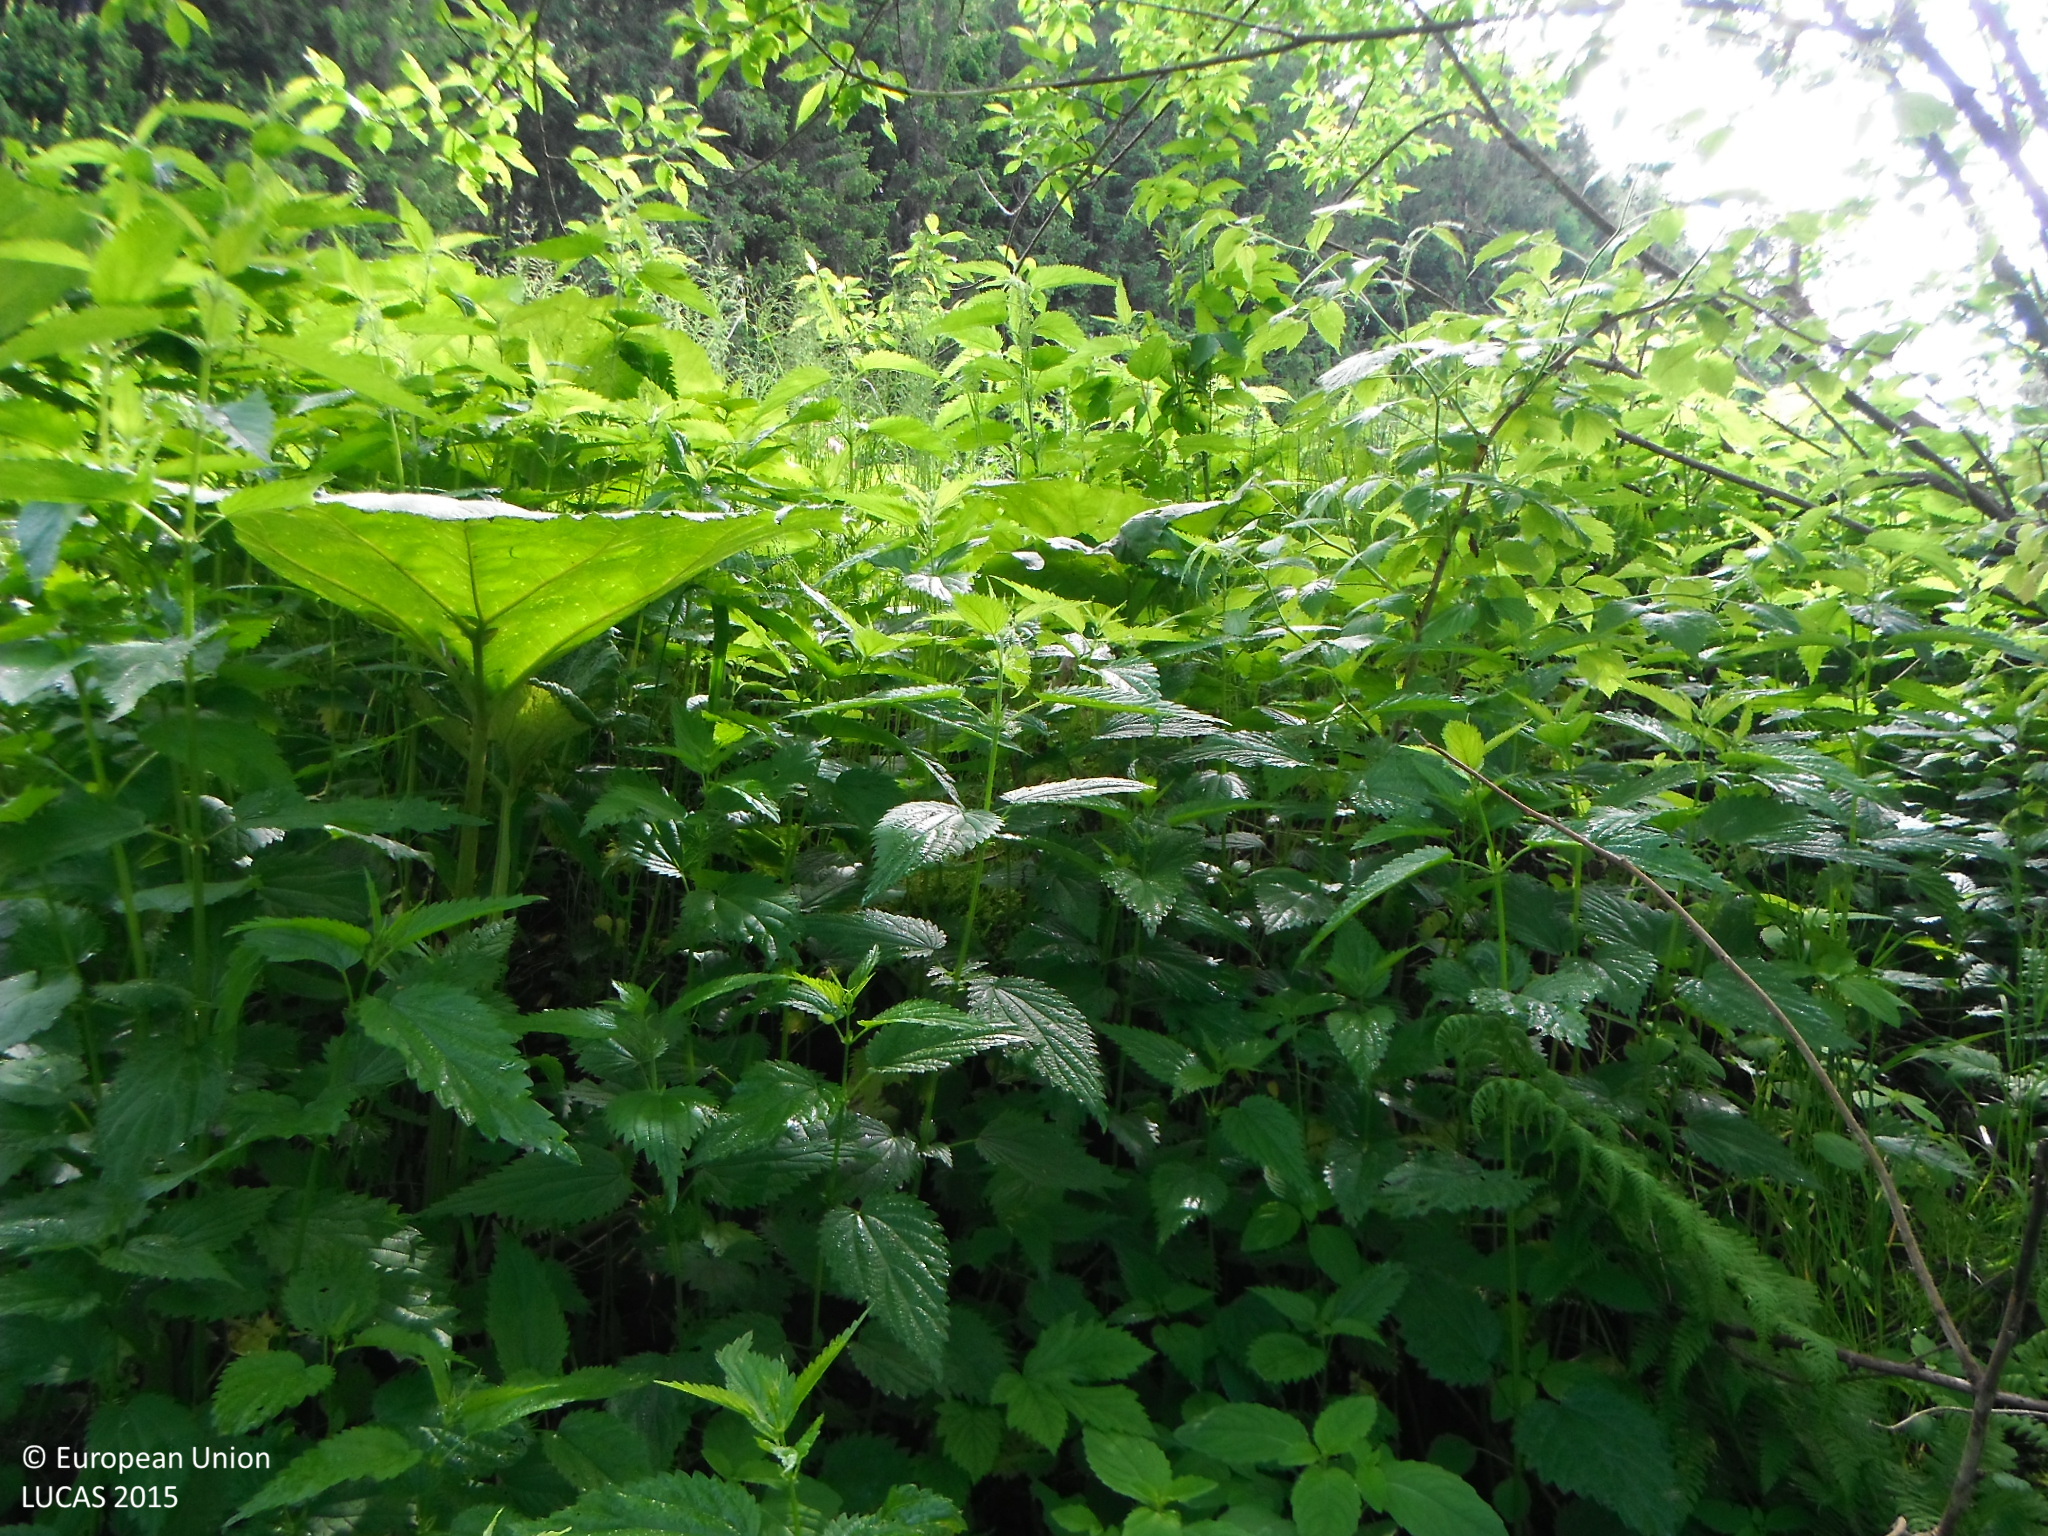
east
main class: Grassland
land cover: Spontaneously vegetated surfaces
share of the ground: > 75 %
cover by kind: herbaceous plants 100 %
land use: Semi-natural and natural areas not in use
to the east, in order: Spontaneously vegetated surfaces; Other bare soil; Tracks; Spruce dominated coniferous woodland
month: June
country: SK
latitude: 48.9450
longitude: 20.0116
